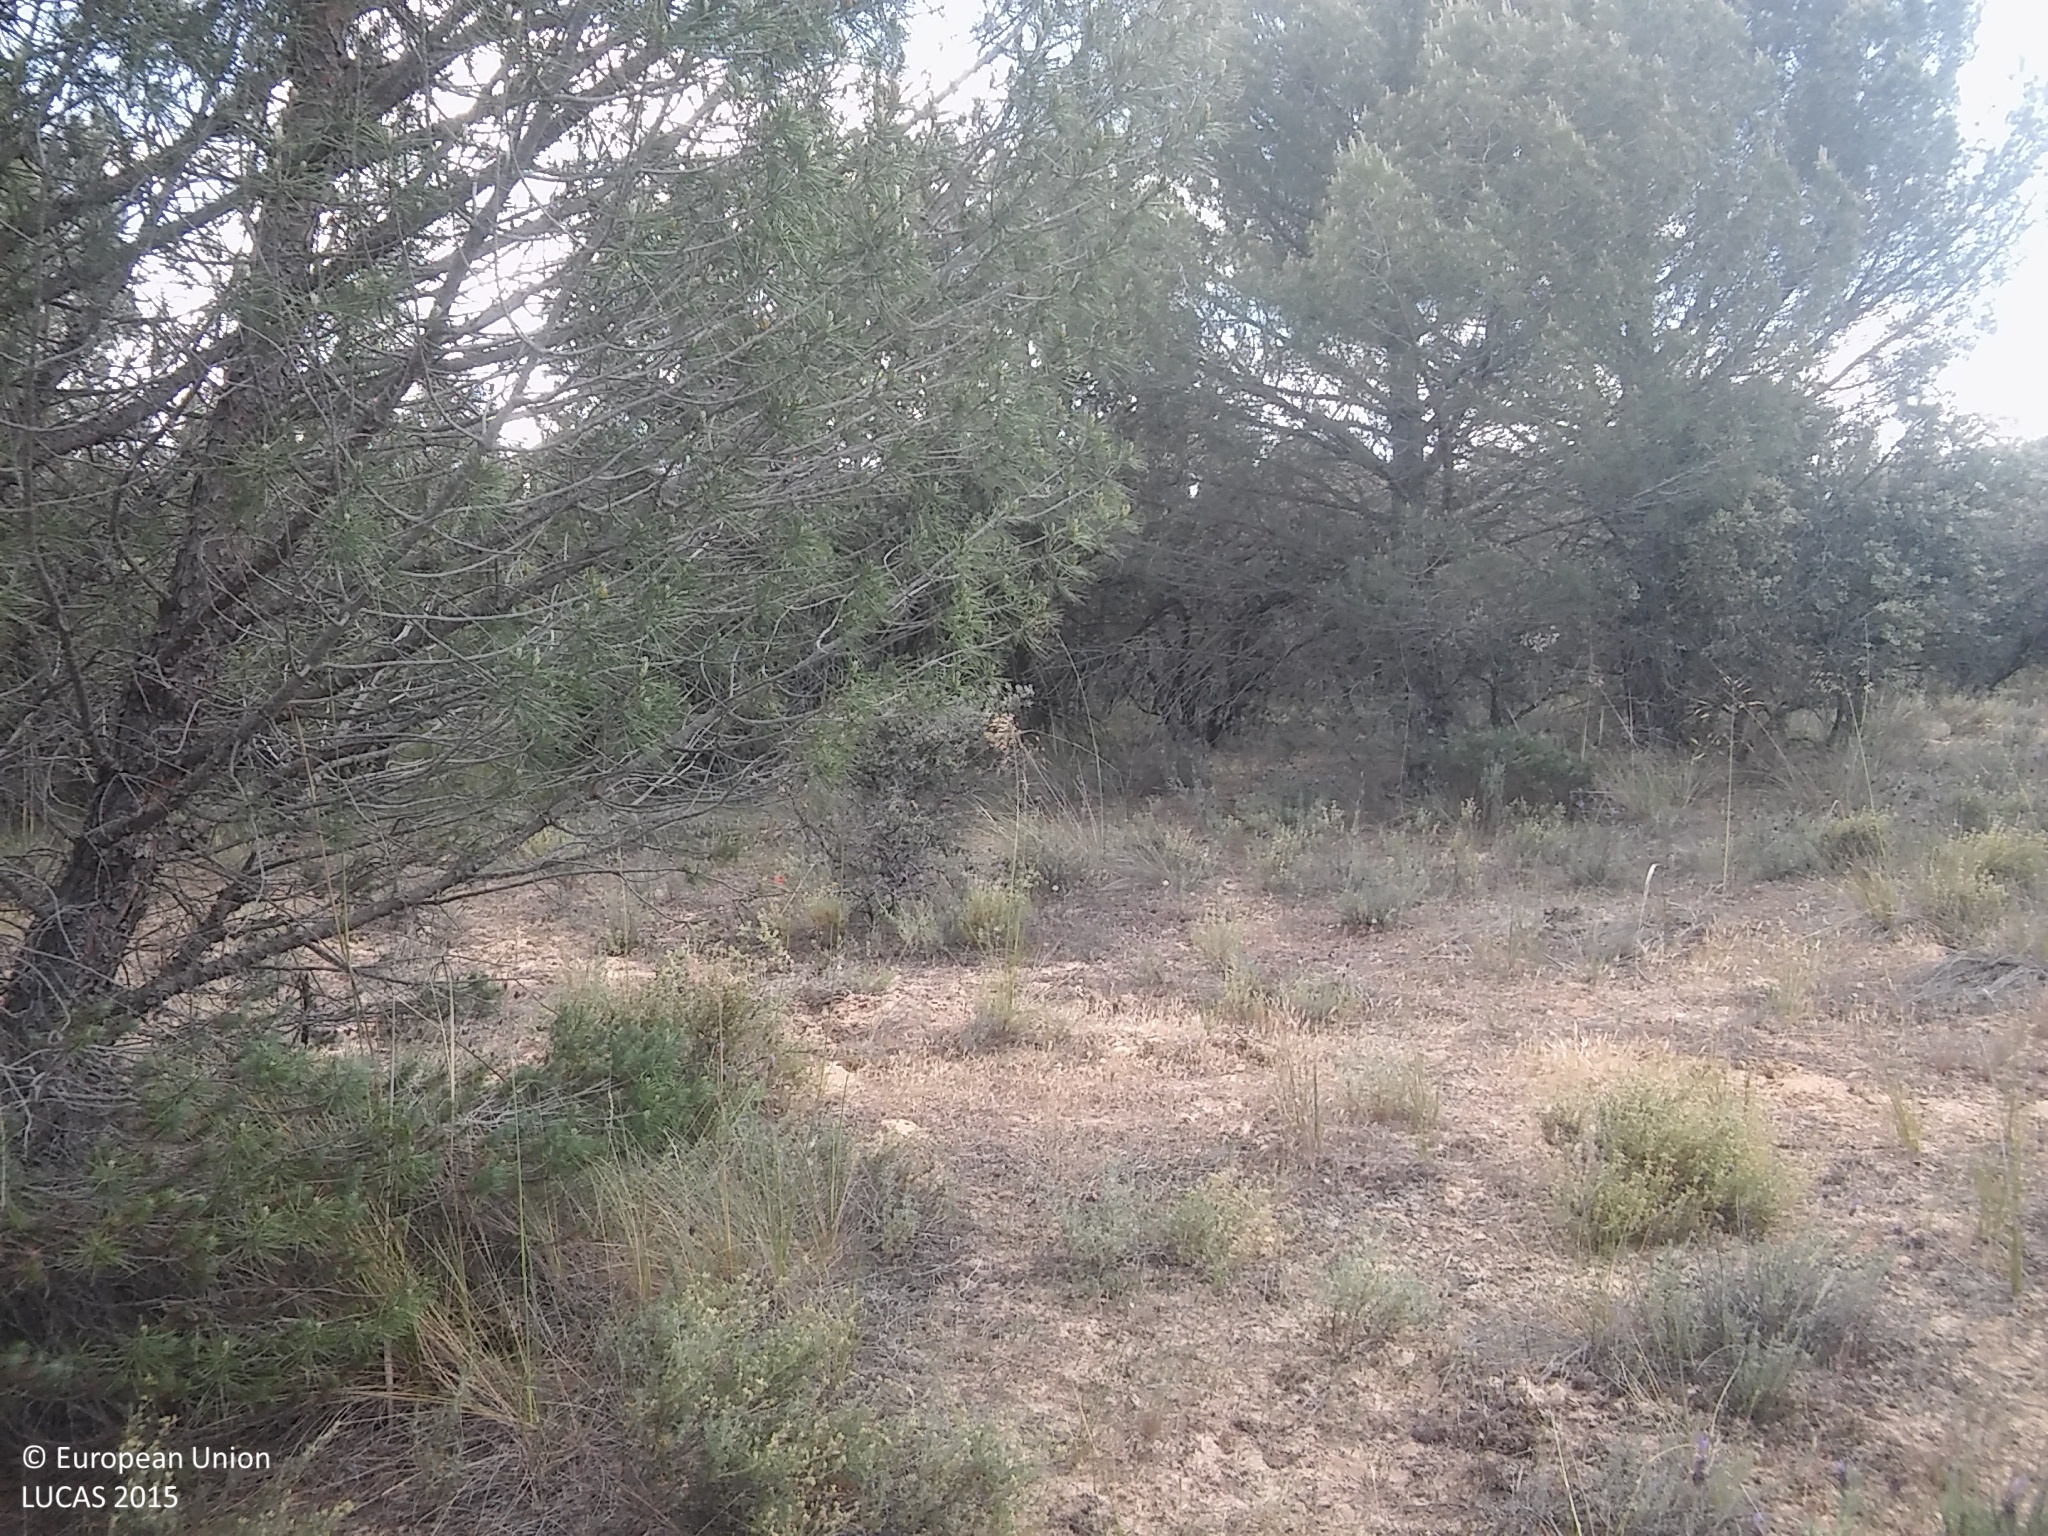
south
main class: Woodland
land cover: Broadleaved woodland
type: broadleaved evergreen forest
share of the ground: 25 - 50 %
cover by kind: broadleaved forest trees 30 %, shrubs 30 %, unconsolidated bare surface 30 %, coniferous forest trees 10 %
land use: Forestry
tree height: > 5 m
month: June
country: ES
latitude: 41.6557
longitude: -3.7550
